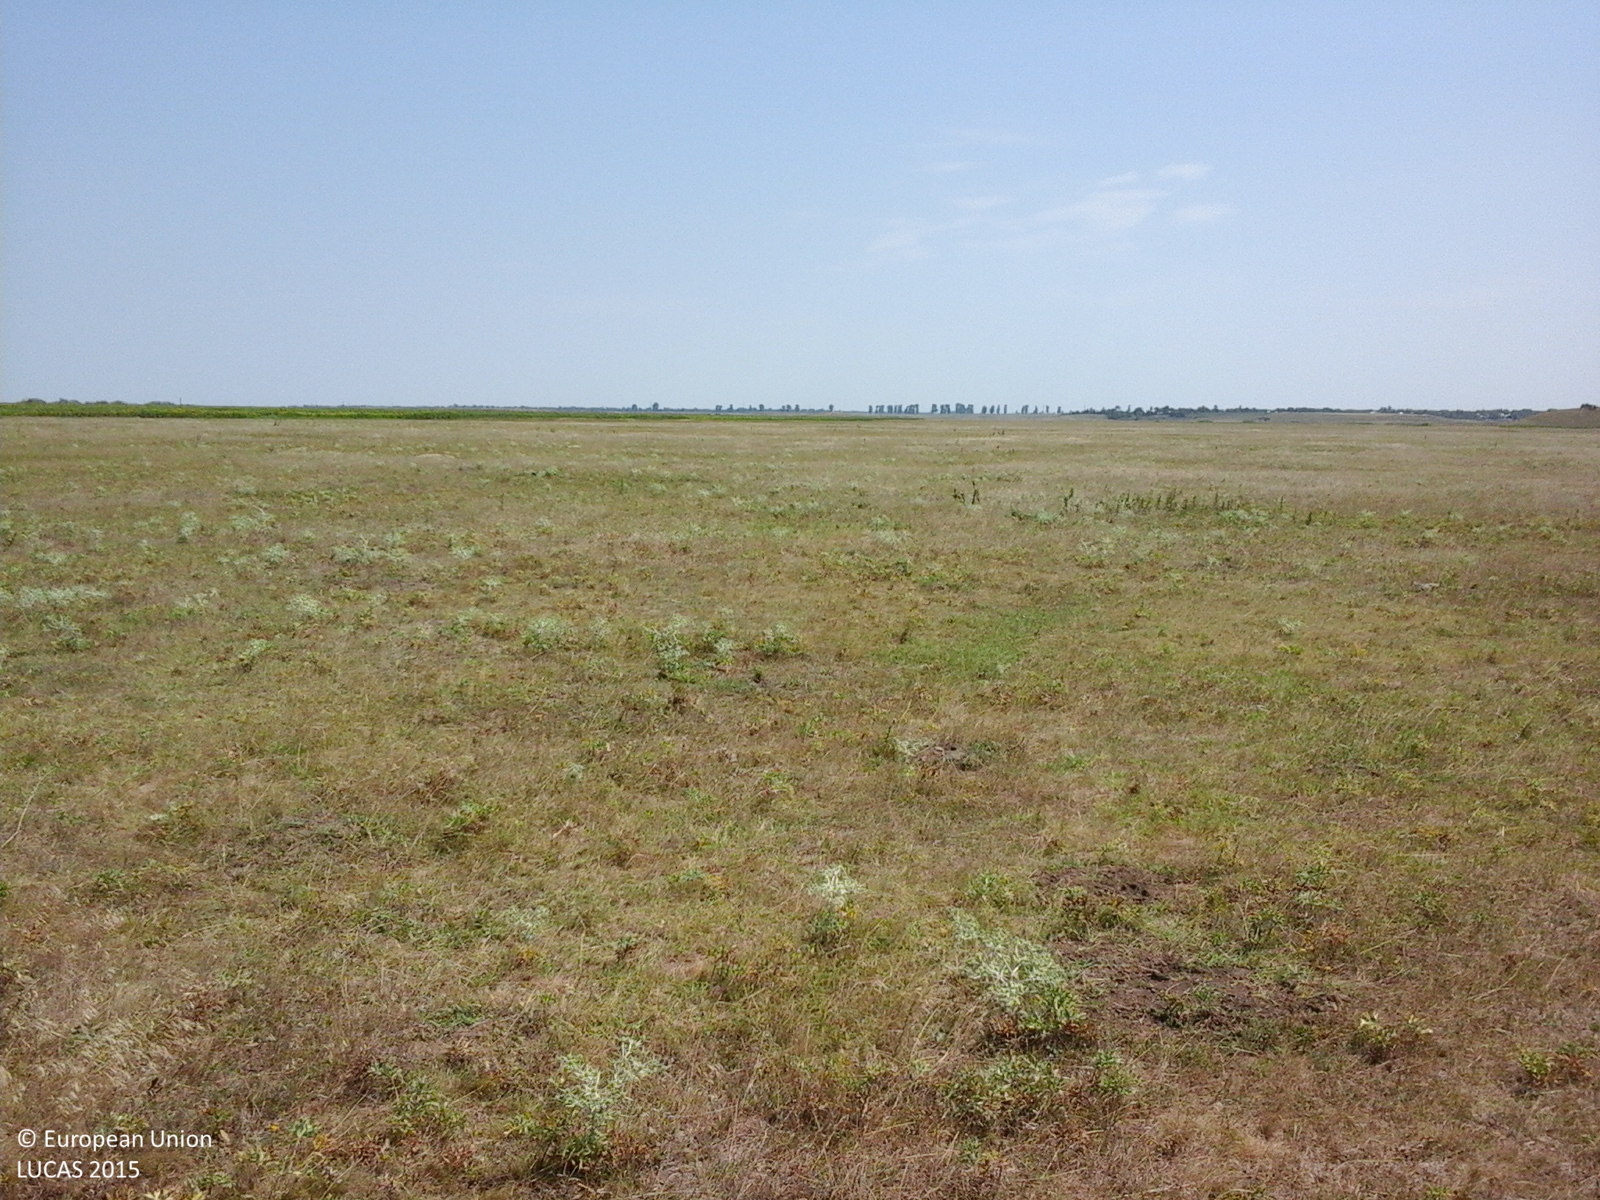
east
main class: Grassland
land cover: Grassland without tree/shrub cover
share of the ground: > 75 %
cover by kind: herbaceous plants 100 %
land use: Agriculture (excluding fallow land and kitchen gardens)
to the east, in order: Grassland without tree/shrub cover; Tracks; Grassland without tree/shrub cover
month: July
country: RO
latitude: 44.9560
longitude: 27.2406
